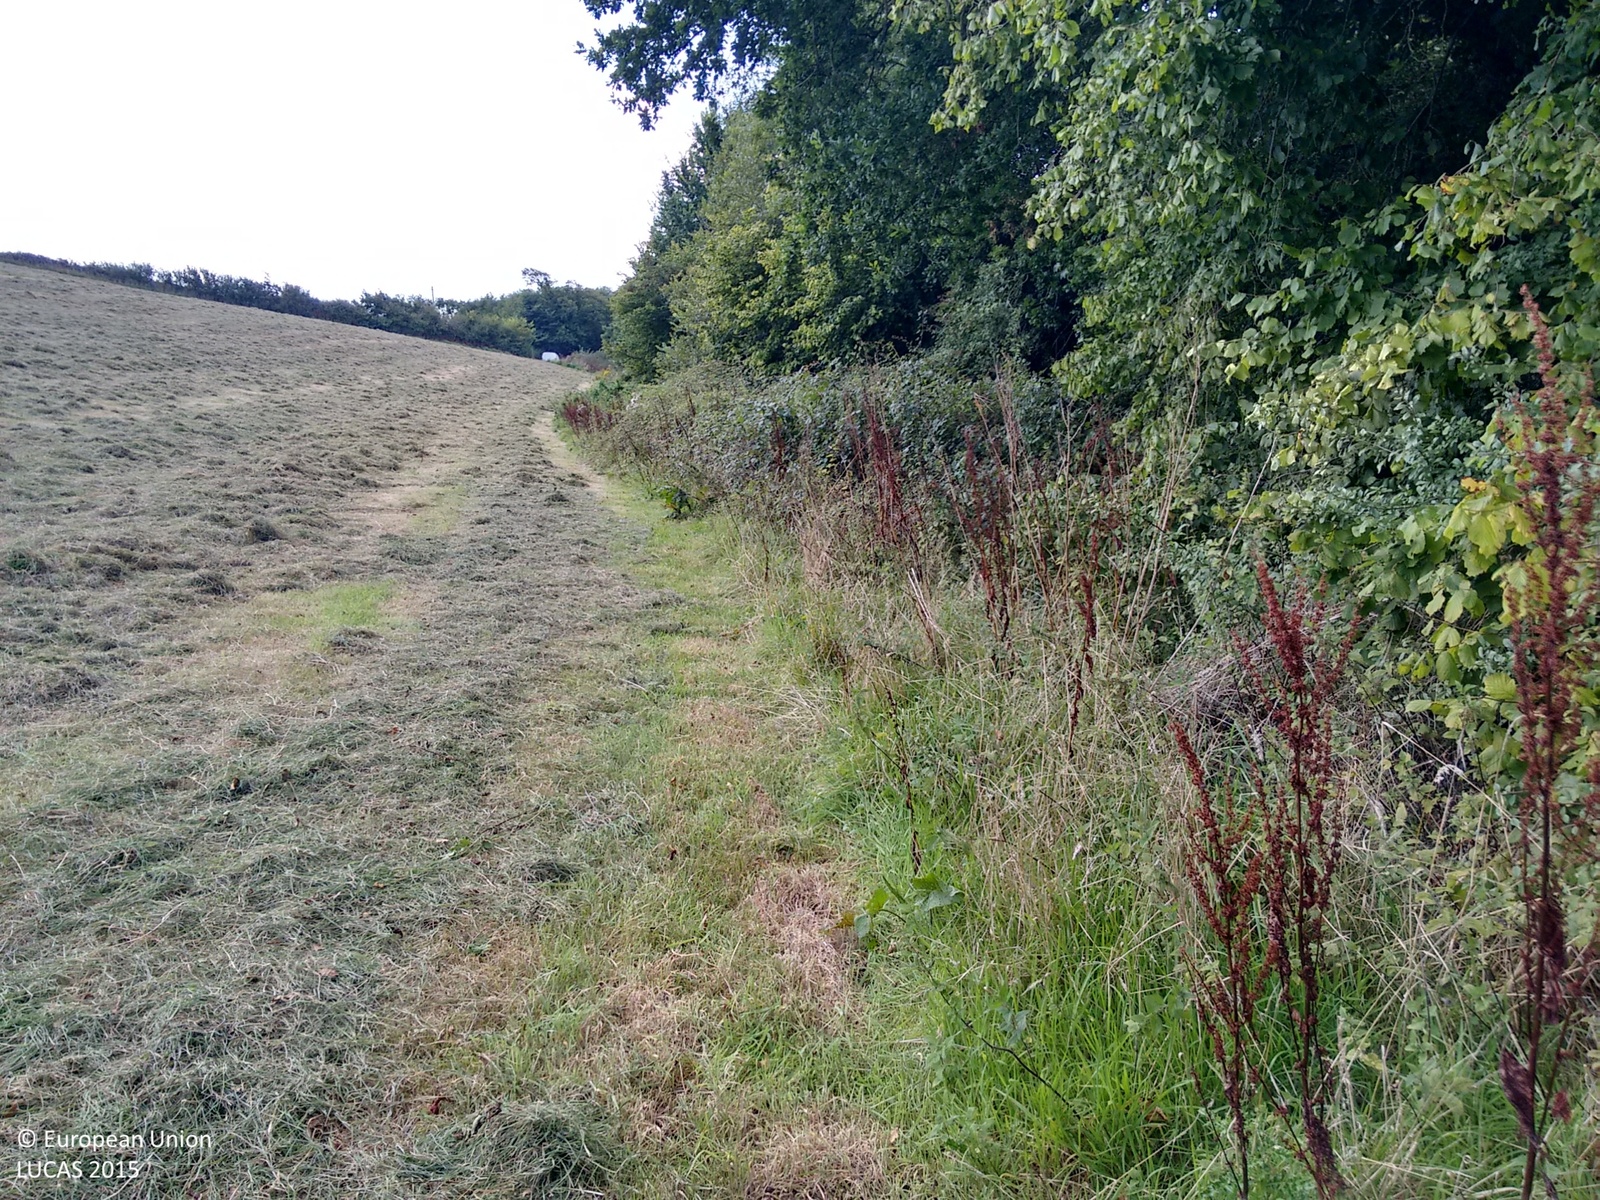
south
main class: Woodland
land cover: Broadleaved woodland
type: hemiboreal forest and nemoral coniferous forest and mixed broadleaved-coniferous forest
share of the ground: > 75 %
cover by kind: broadleaved forest trees 95 %, shrubs 5 %
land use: Semi-natural and natural areas not in use
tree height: > 5 m
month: September
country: GB
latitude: 51.0179
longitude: -4.2551
